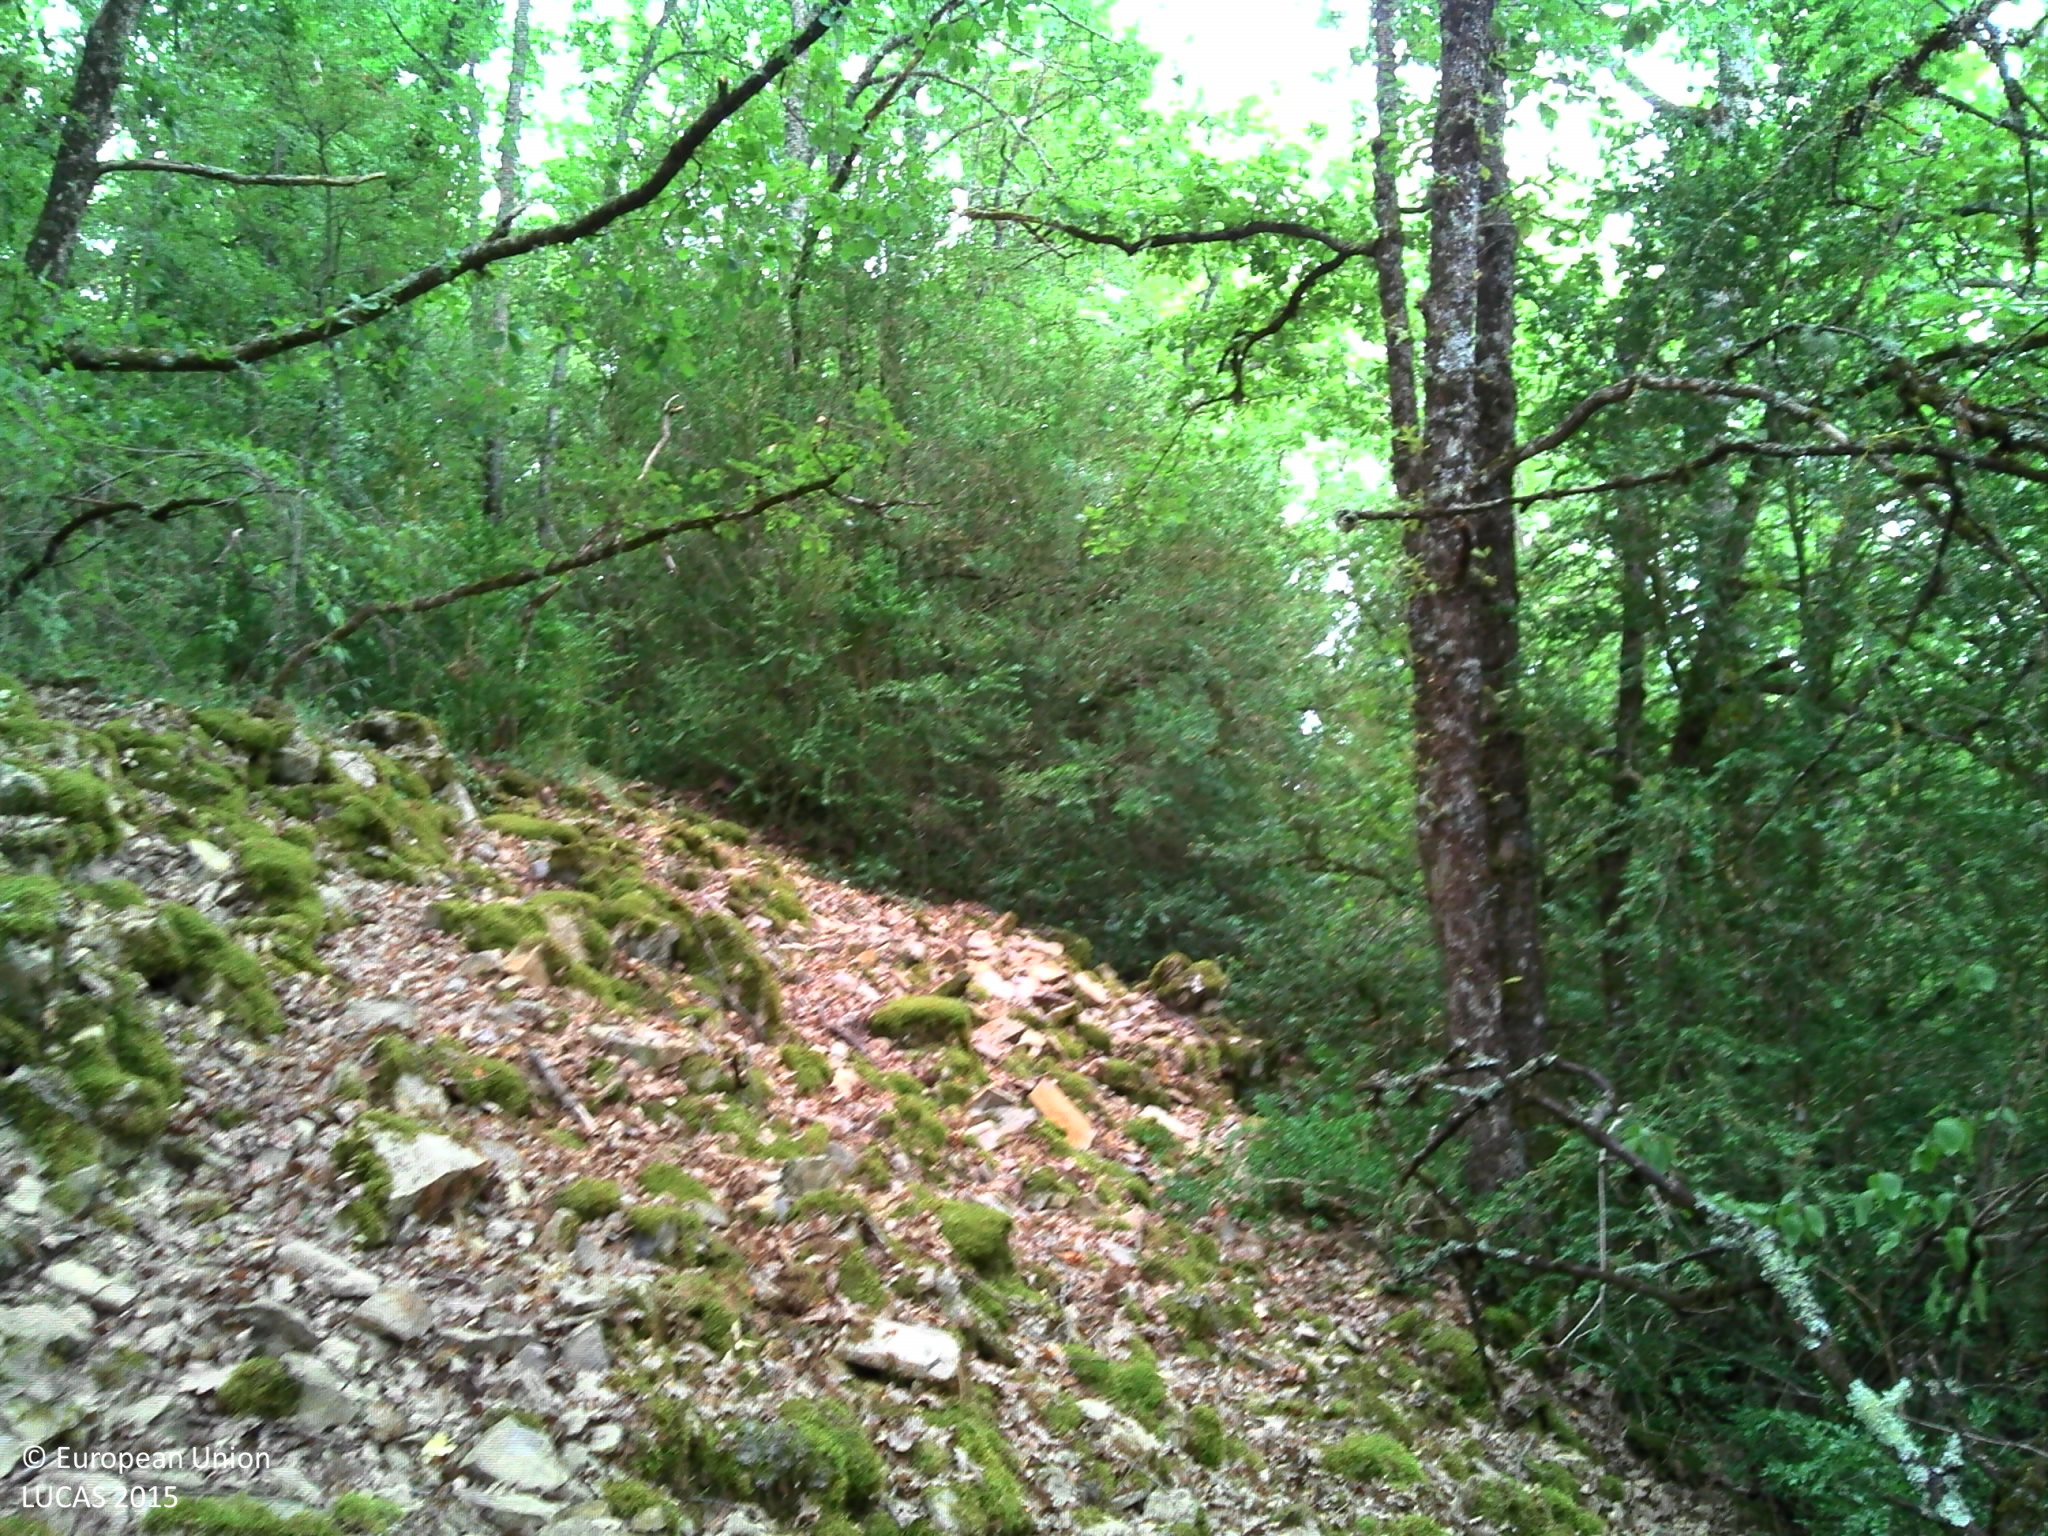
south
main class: Woodland
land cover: Broadleaved woodland
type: mesophytic deciduous forest
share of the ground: > 75 %
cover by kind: broadleaved forest trees 65 %, lichens and mosses 15 %, herbaceous plants 10 %, unconsolidated bare surface 10 %
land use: Forestry
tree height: > 5 m
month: August
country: FR
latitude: 44.0438
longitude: 3.3048
